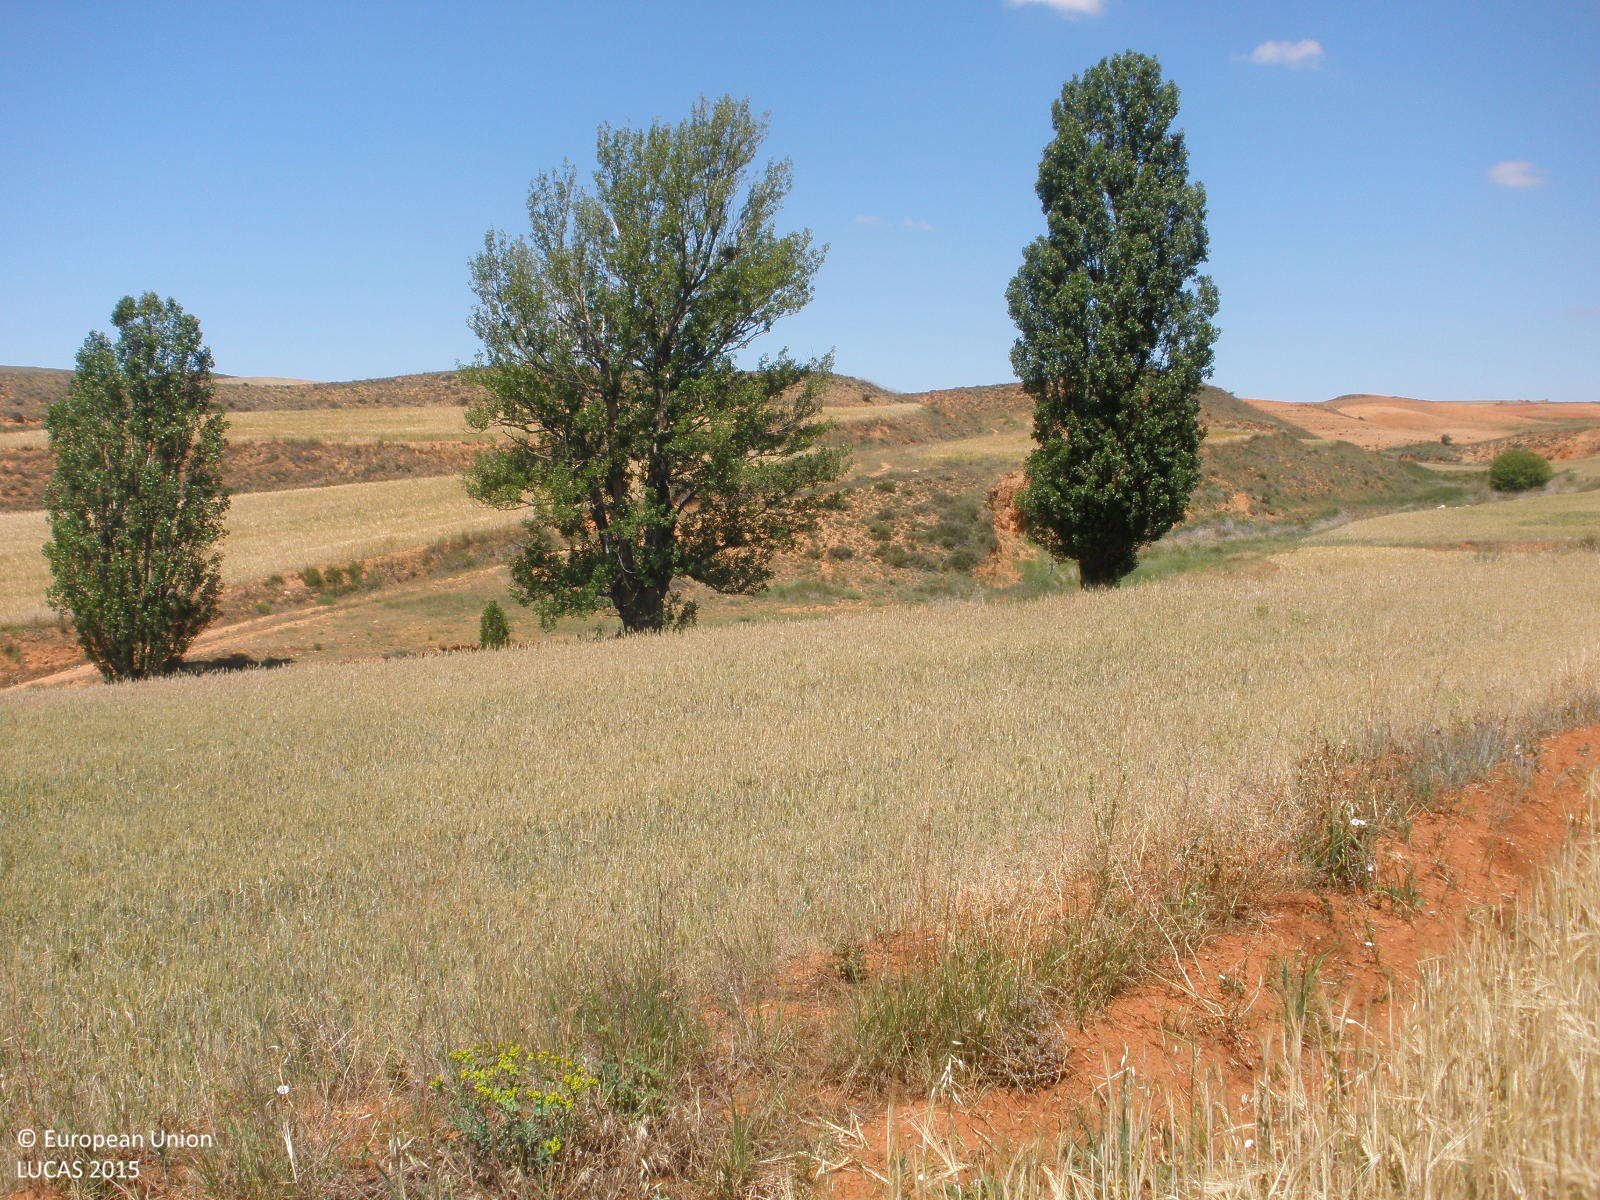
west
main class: Cropland
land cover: Barley
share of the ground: > 75 %
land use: Agriculture (excluding fallow land and kitchen gardens)
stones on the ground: < 10 %
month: June
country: ES
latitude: 40.5528
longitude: -1.0539
